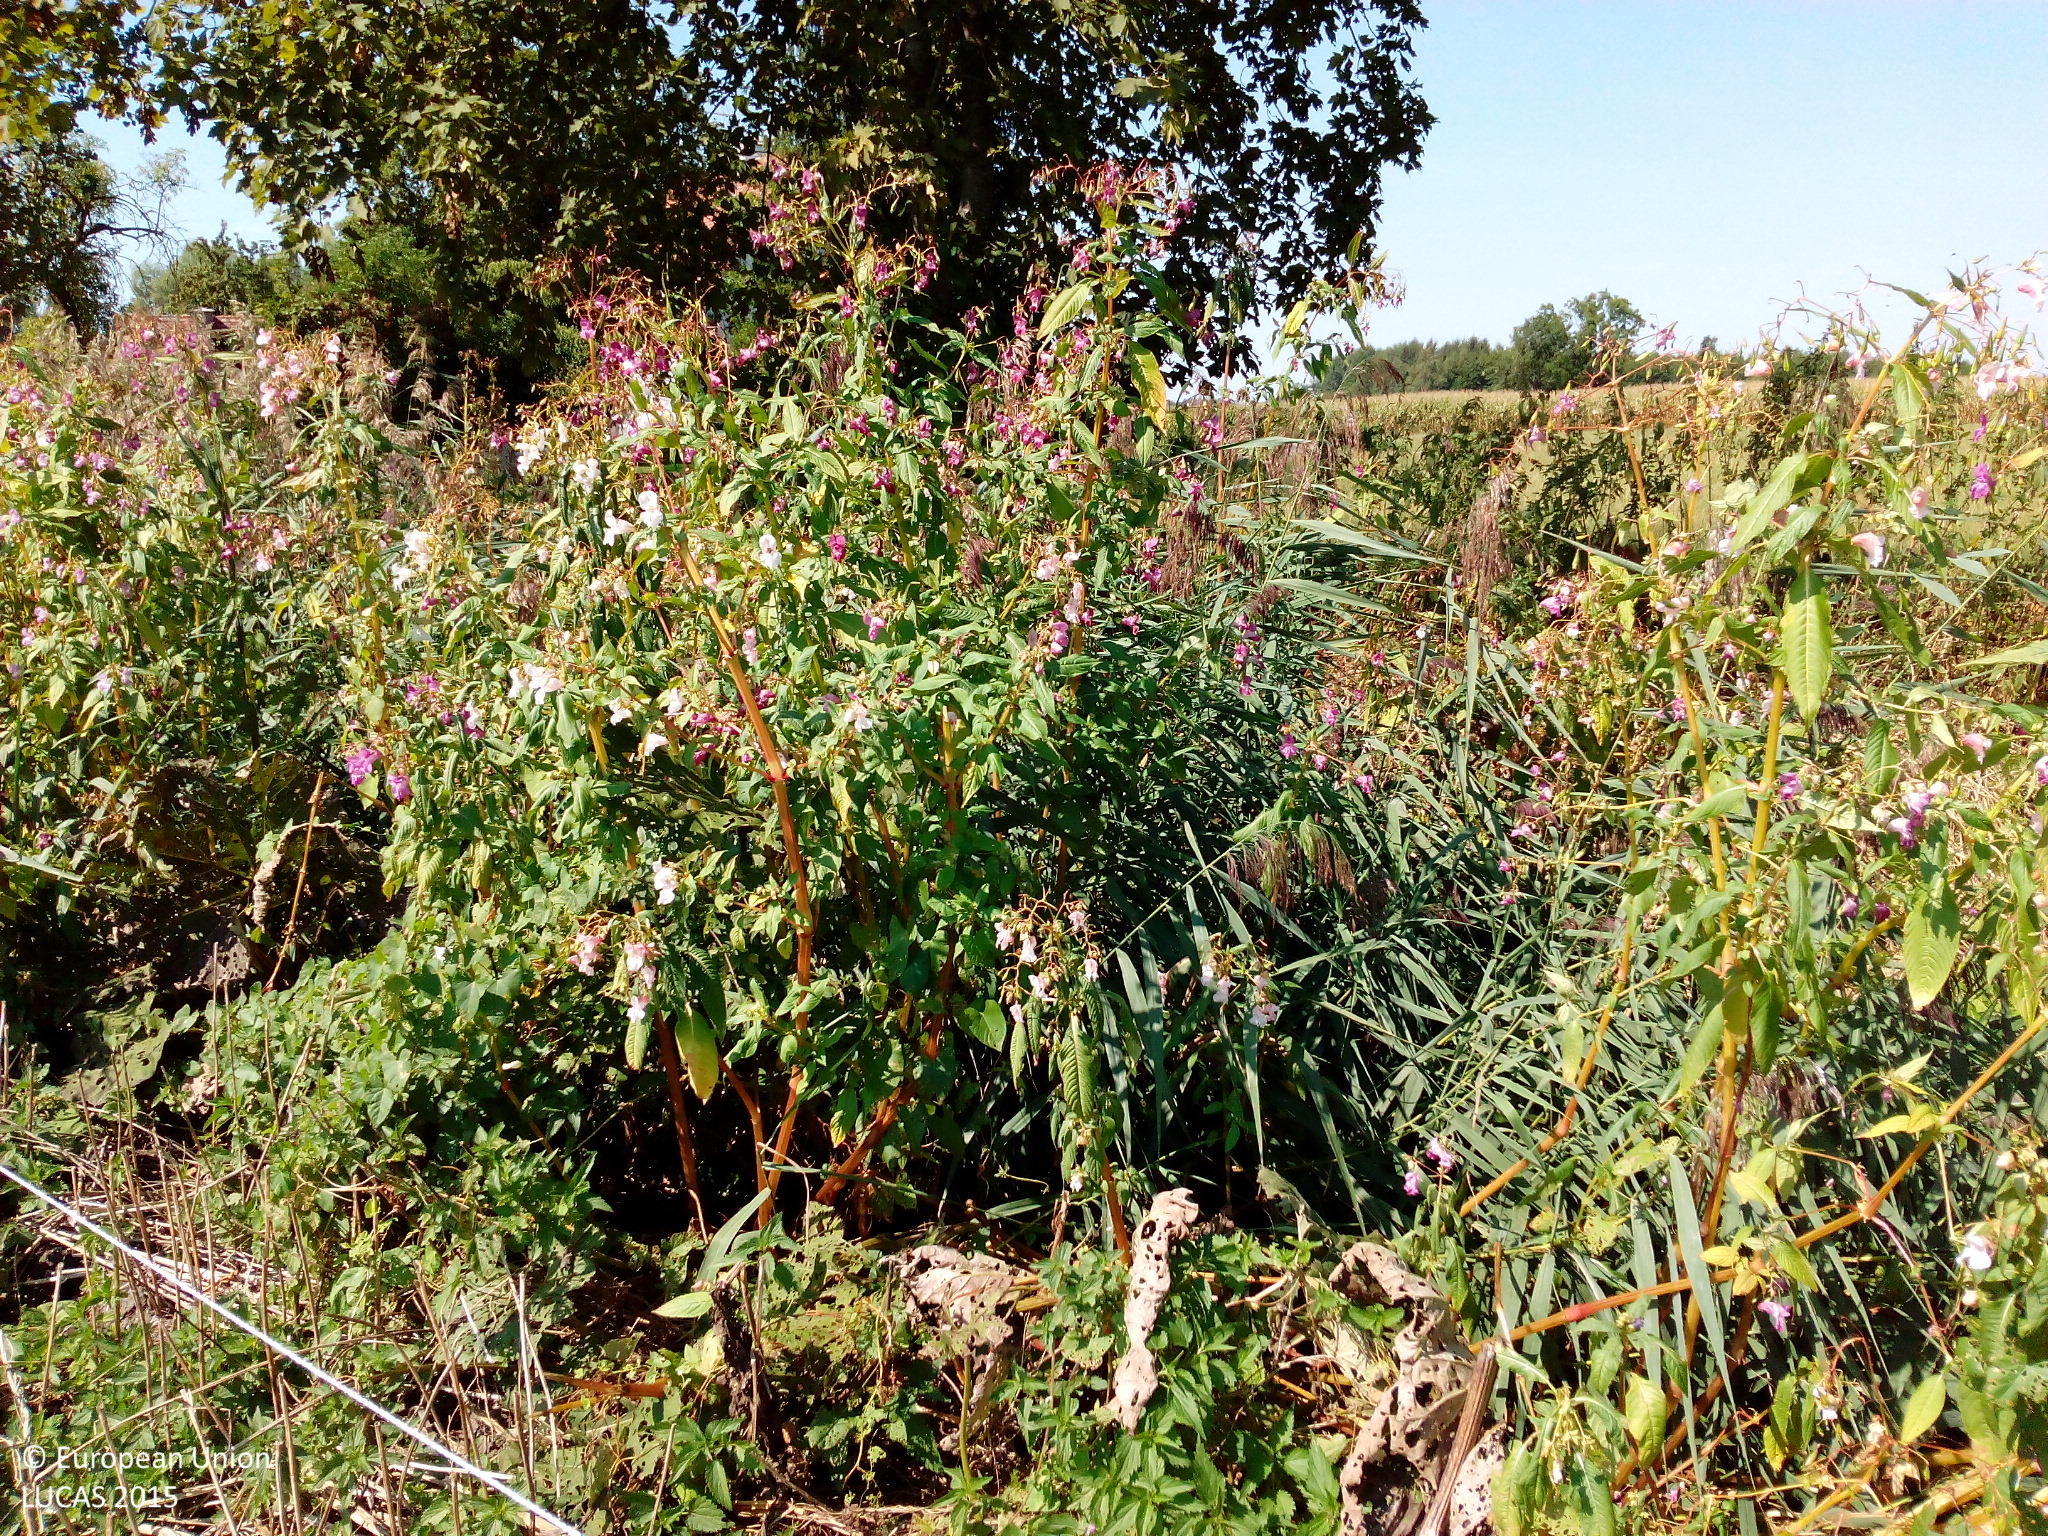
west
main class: Grassland
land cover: Grassland without tree/shrub cover
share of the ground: > 75 %
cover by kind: herbaceous plants 95 %, unconsolidated bare surface 5 %
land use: Agriculture (excluding fallow land and kitchen gardens)
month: August
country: DE
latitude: 48.4931
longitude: 10.2570
